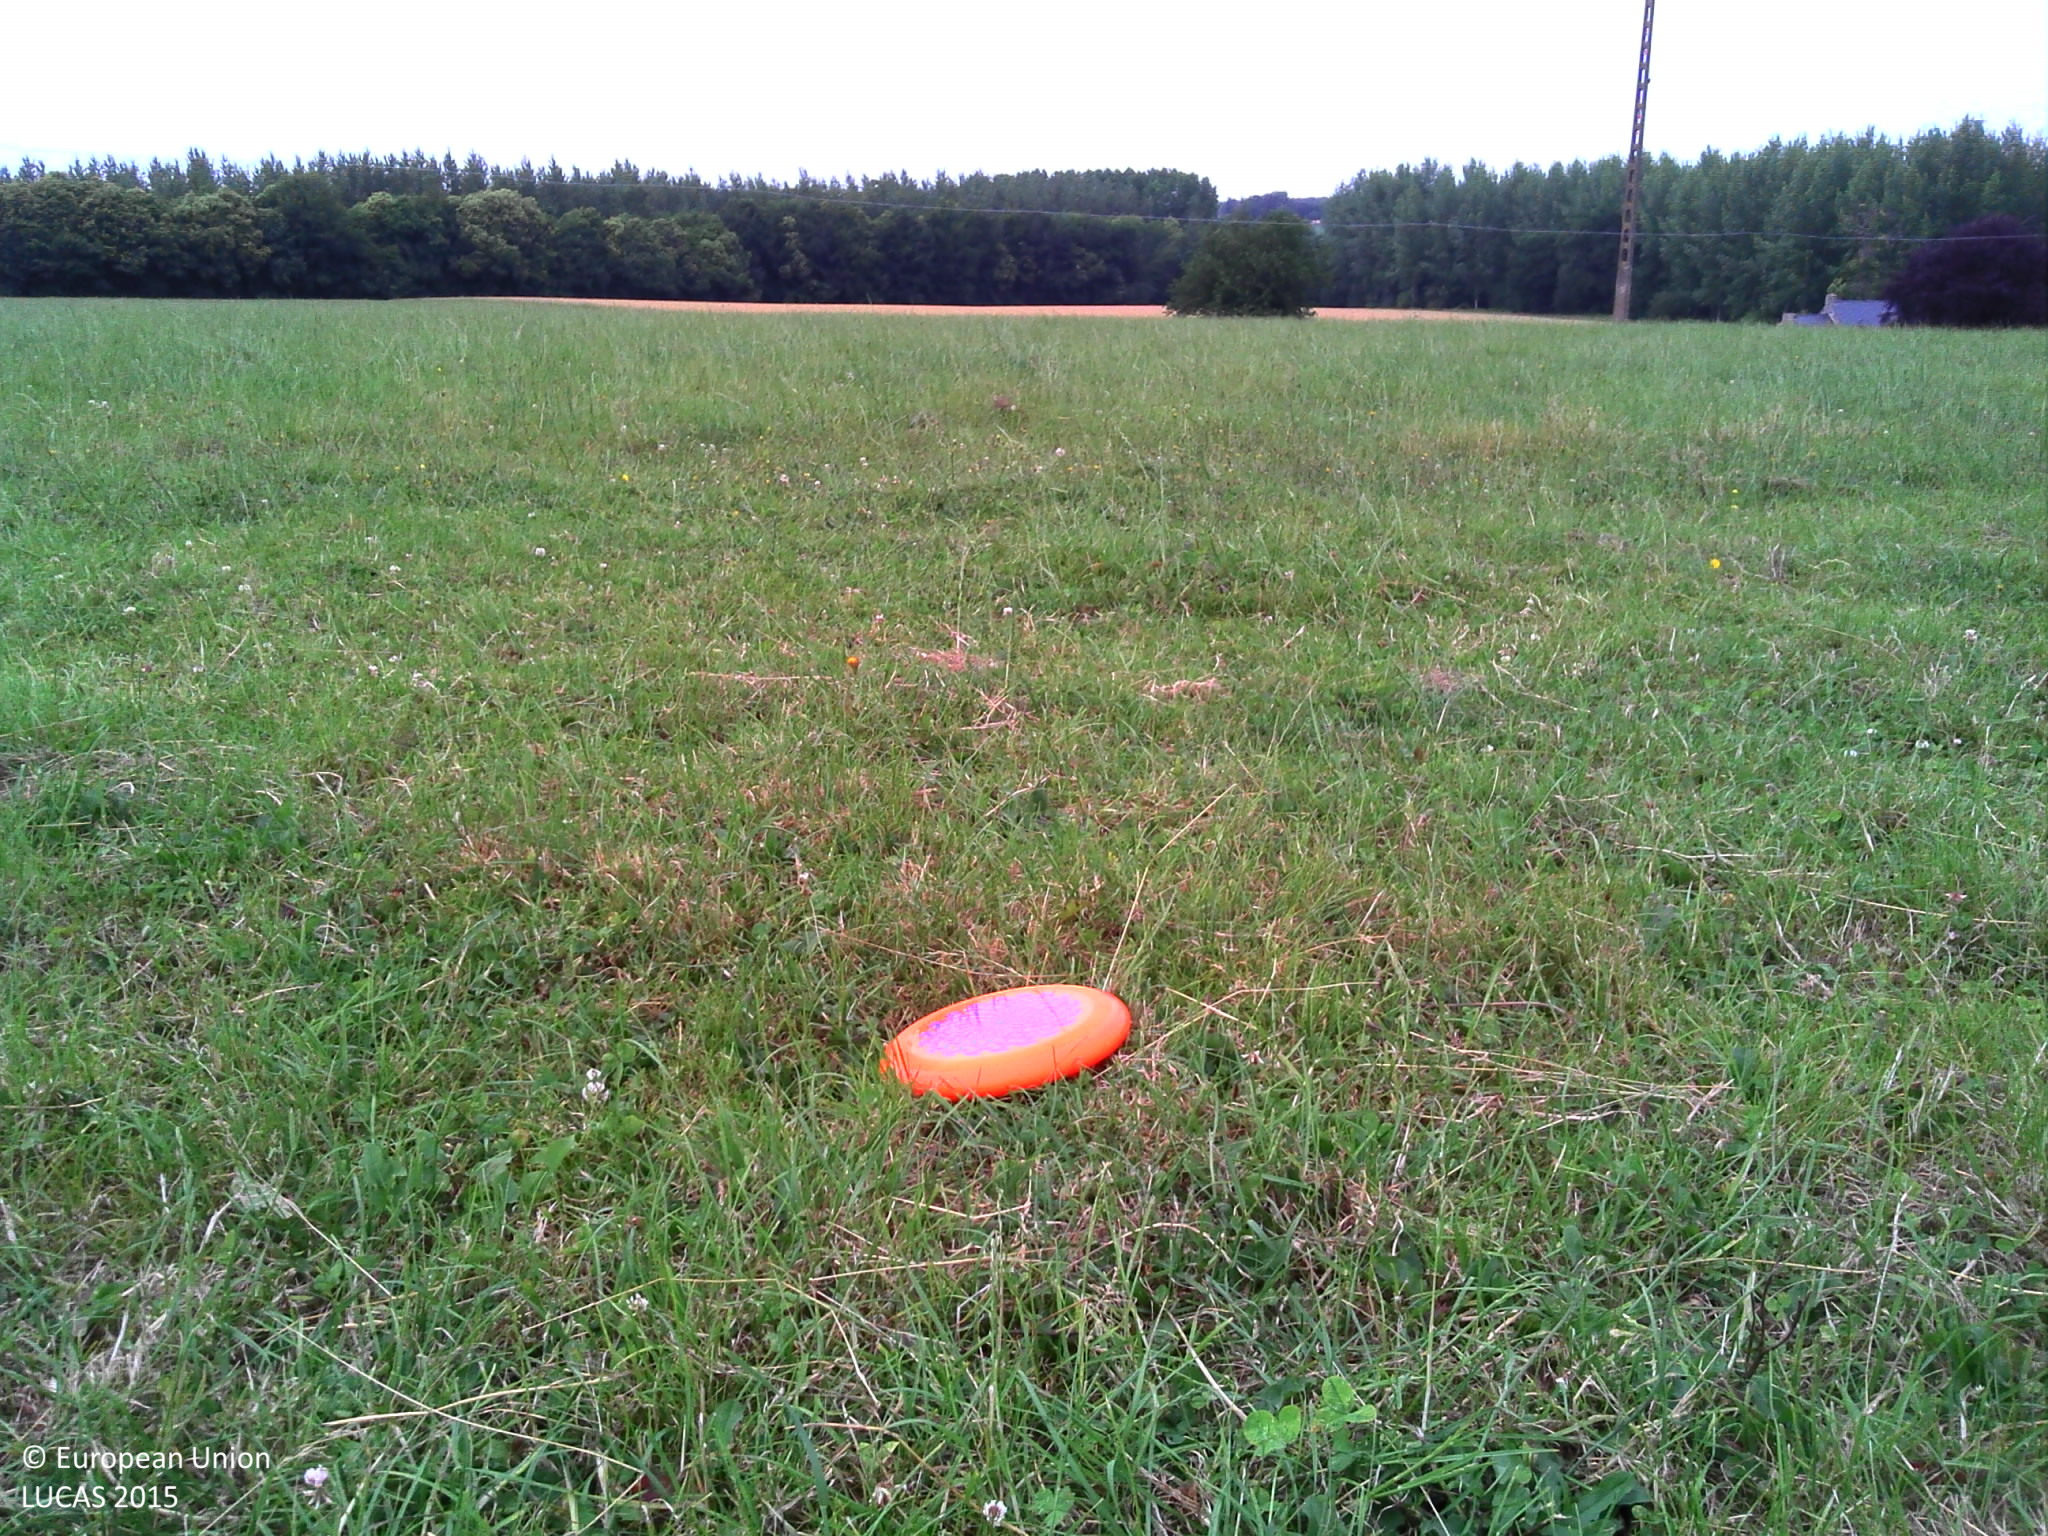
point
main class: Grassland
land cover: Grassland without tree/shrub cover
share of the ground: > 75 %
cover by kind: herbaceous plants 75 %, unconsolidated bare surface 25 %
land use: Agriculture (excluding fallow land and kitchen gardens)
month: July
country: FR
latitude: 48.5223
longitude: -2.0647
